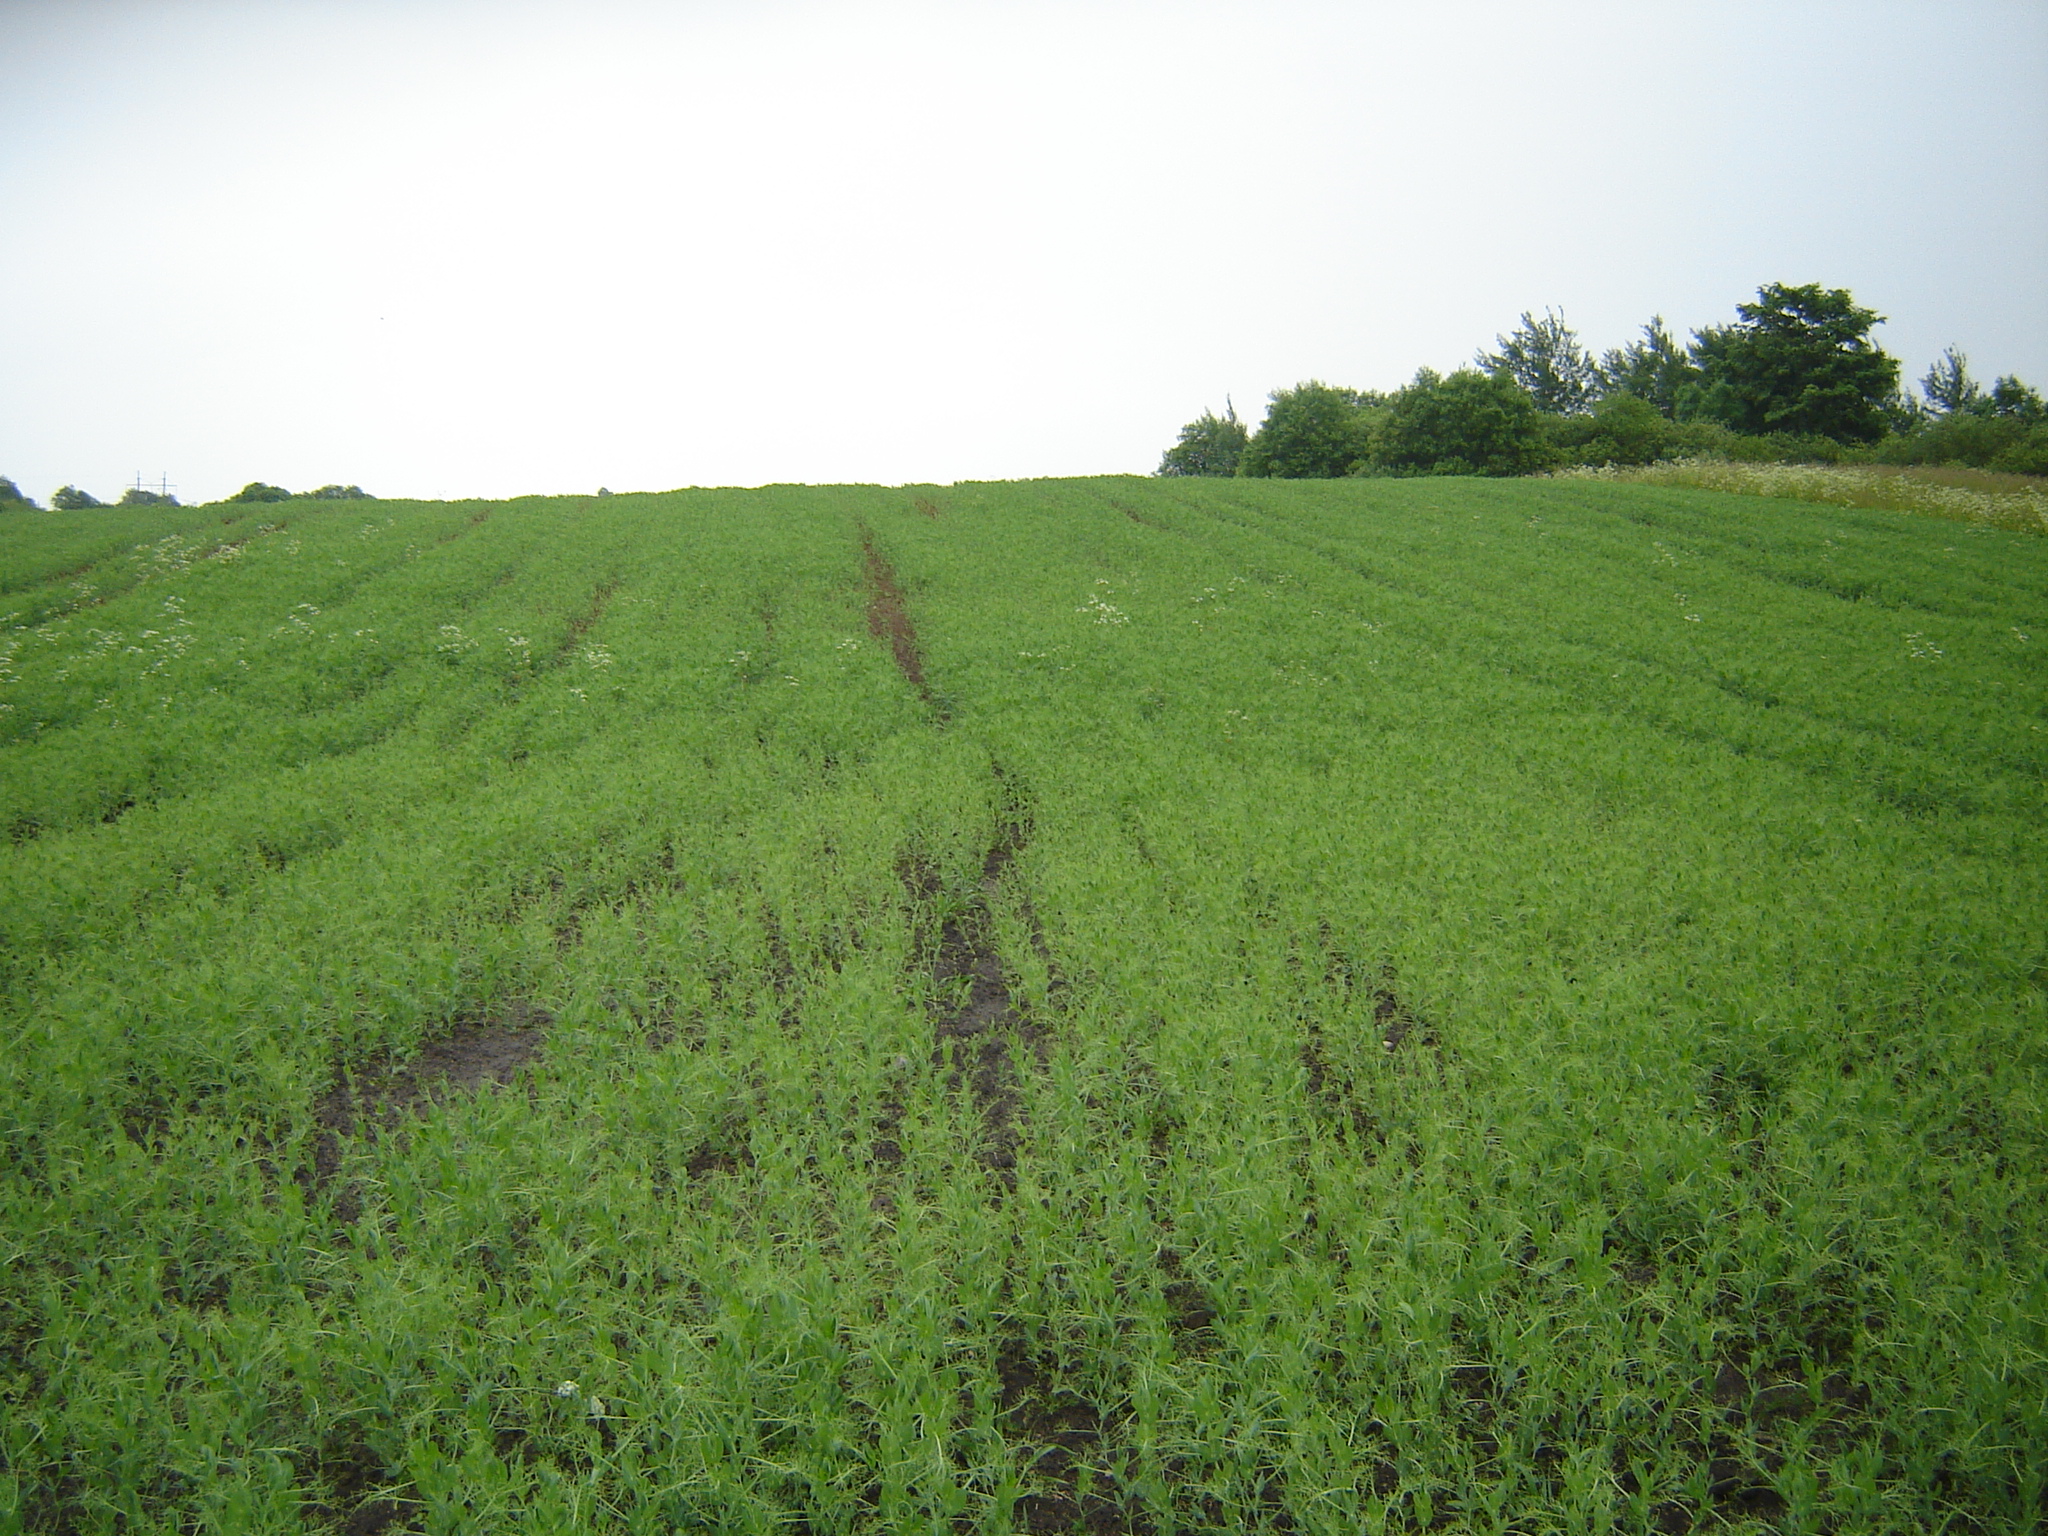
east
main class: Cropland
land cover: Dry pulses
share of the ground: > 75 %
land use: Agriculture (excluding fallow land and kitchen gardens)
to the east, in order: Dry pulses; Grass margins; Dry pulses; Shrubland with sparse tree cover
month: June
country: LT
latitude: 55.5606
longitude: 25.2596
